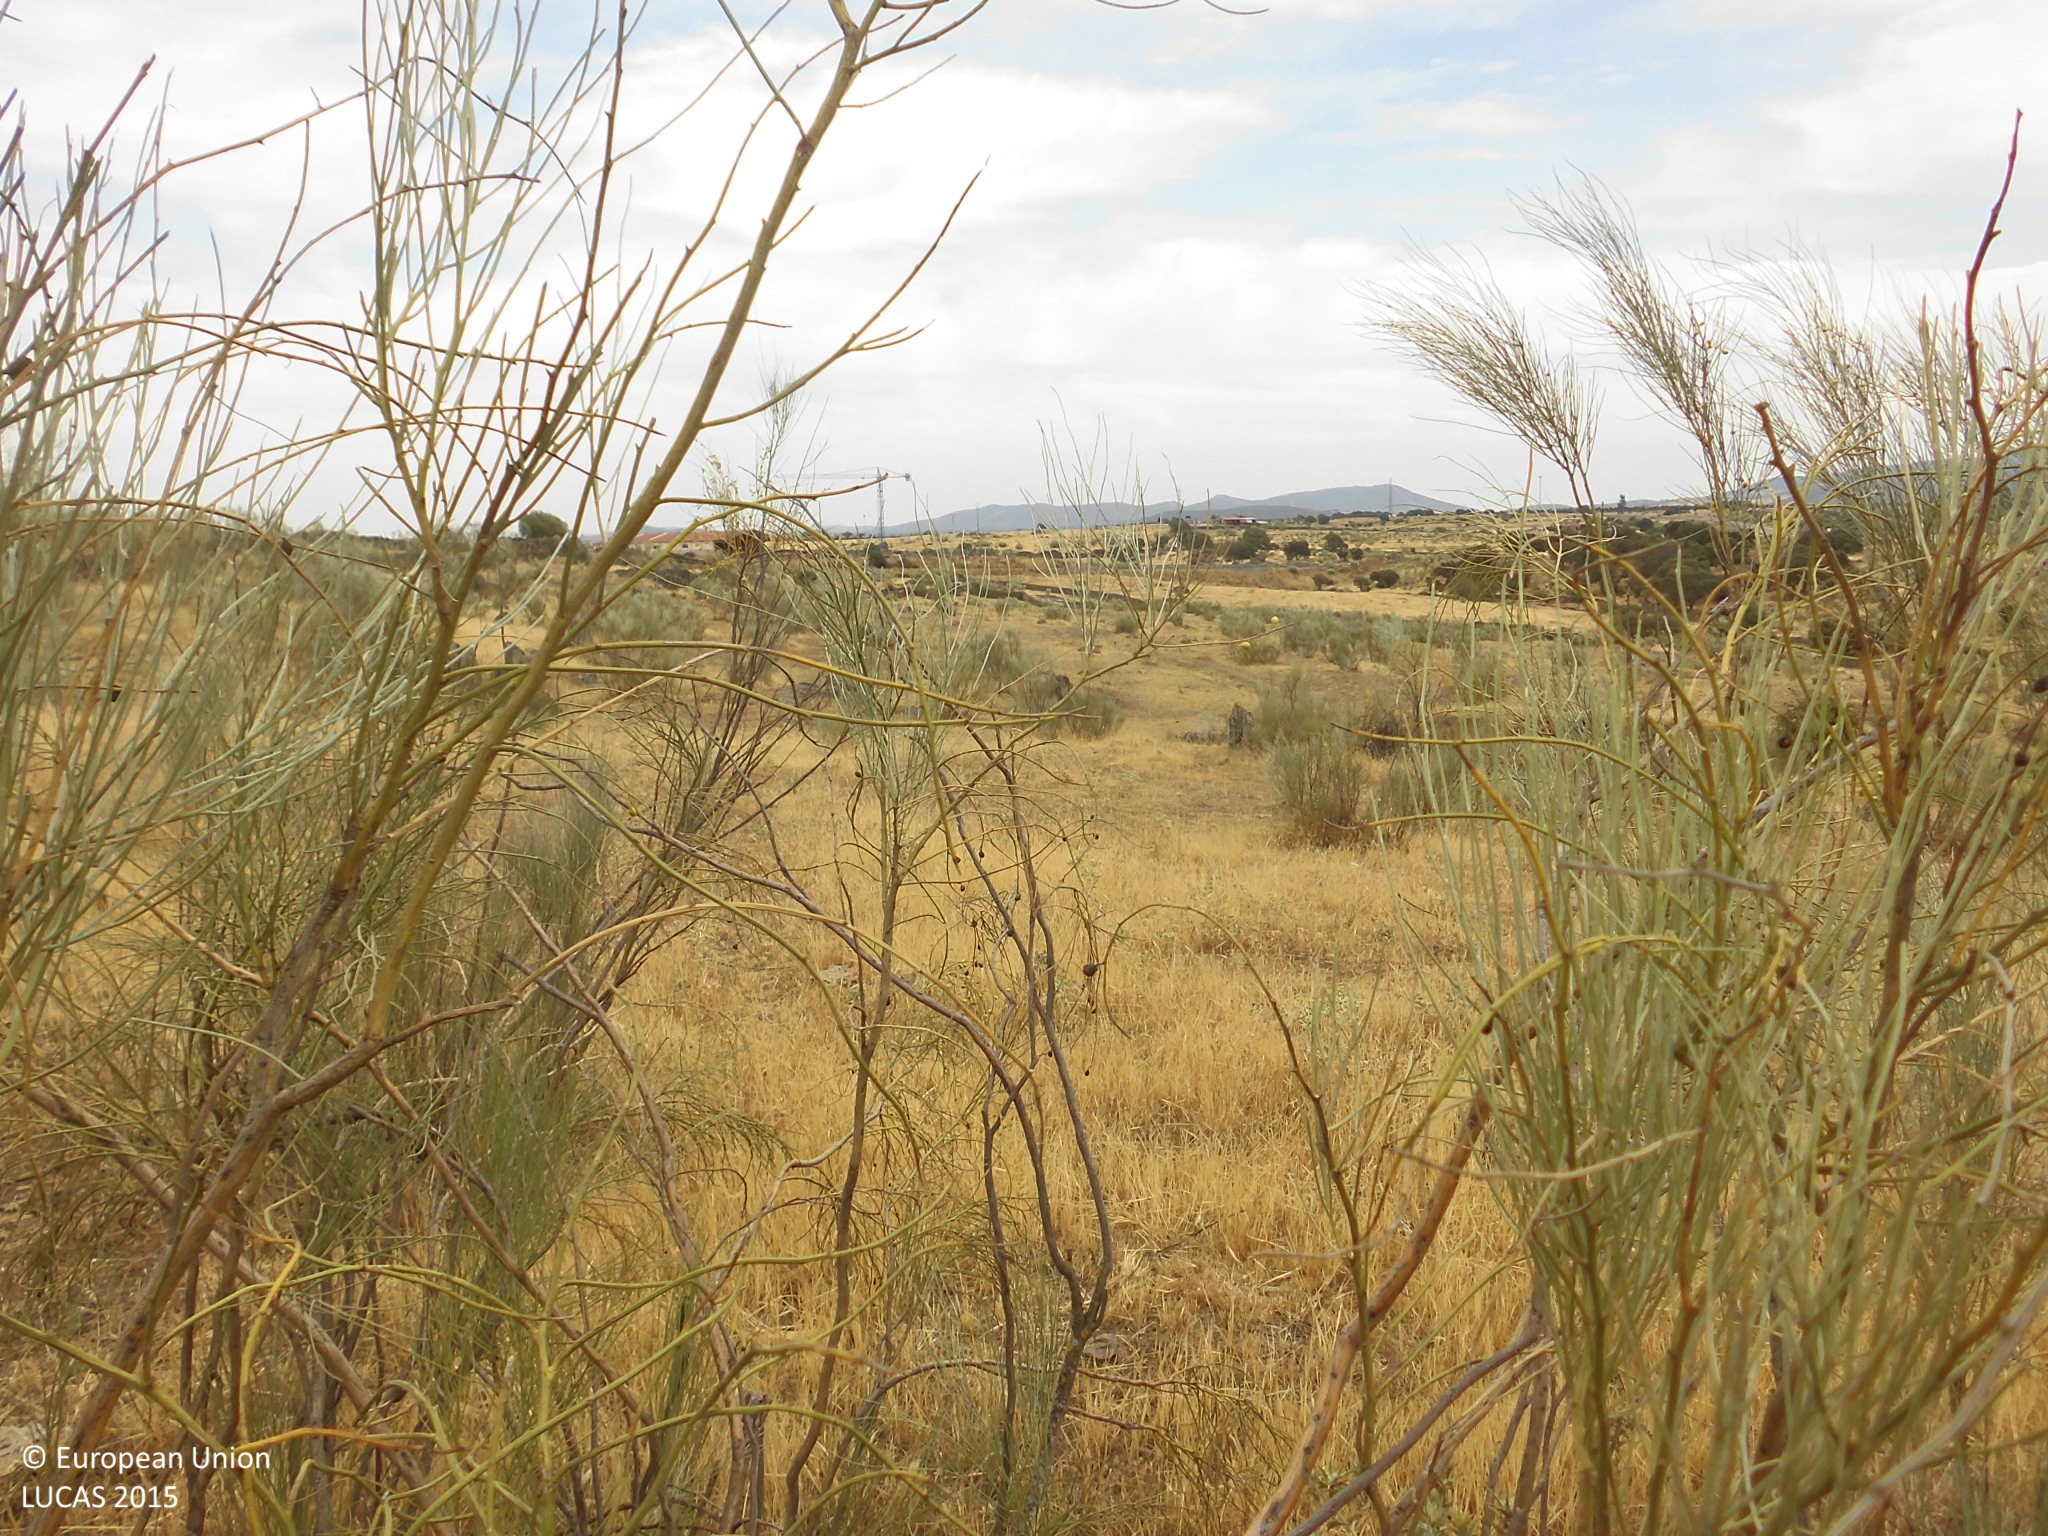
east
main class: Shrubland
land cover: Shrubland without tree cover
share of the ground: 10 - 25 %
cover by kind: herbaceous plants 75 %, shrubs 20 %, consolidated bare surface 5 %
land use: Agriculture (excluding fallow land and kitchen gardens)
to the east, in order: Shrubland without tree cover; Dry stone walls; Shrubland without tree cover; Tracks; Shrubland without tree cover; Dry stone walls; Grassland without tree/shrub cover; Dry stone walls; Grassland without tree/shrub cover
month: July
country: ES
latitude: 39.8934
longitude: -6.4856
